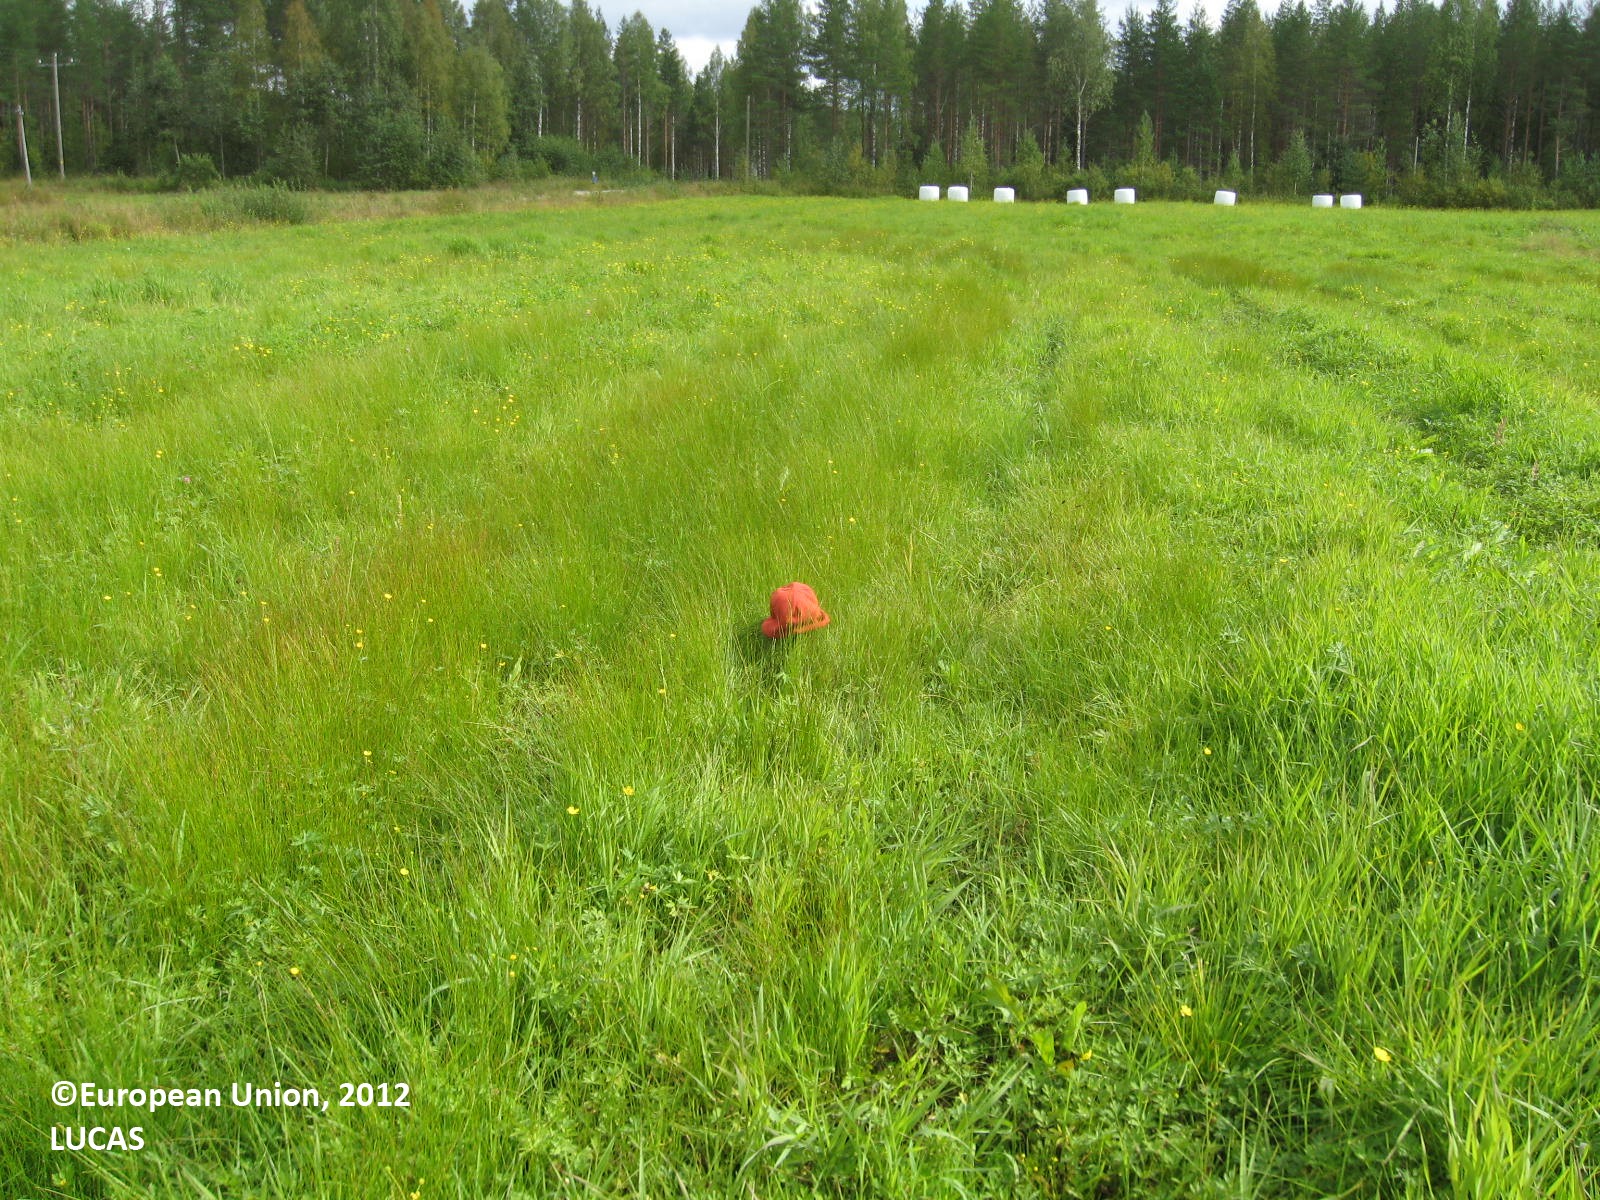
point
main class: Cropland
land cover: Temporary grasslands
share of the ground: > 75 %
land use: Agriculture (excluding fallow land and kitchen gardens)
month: August
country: FI
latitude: 63.5917
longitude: 29.2605
